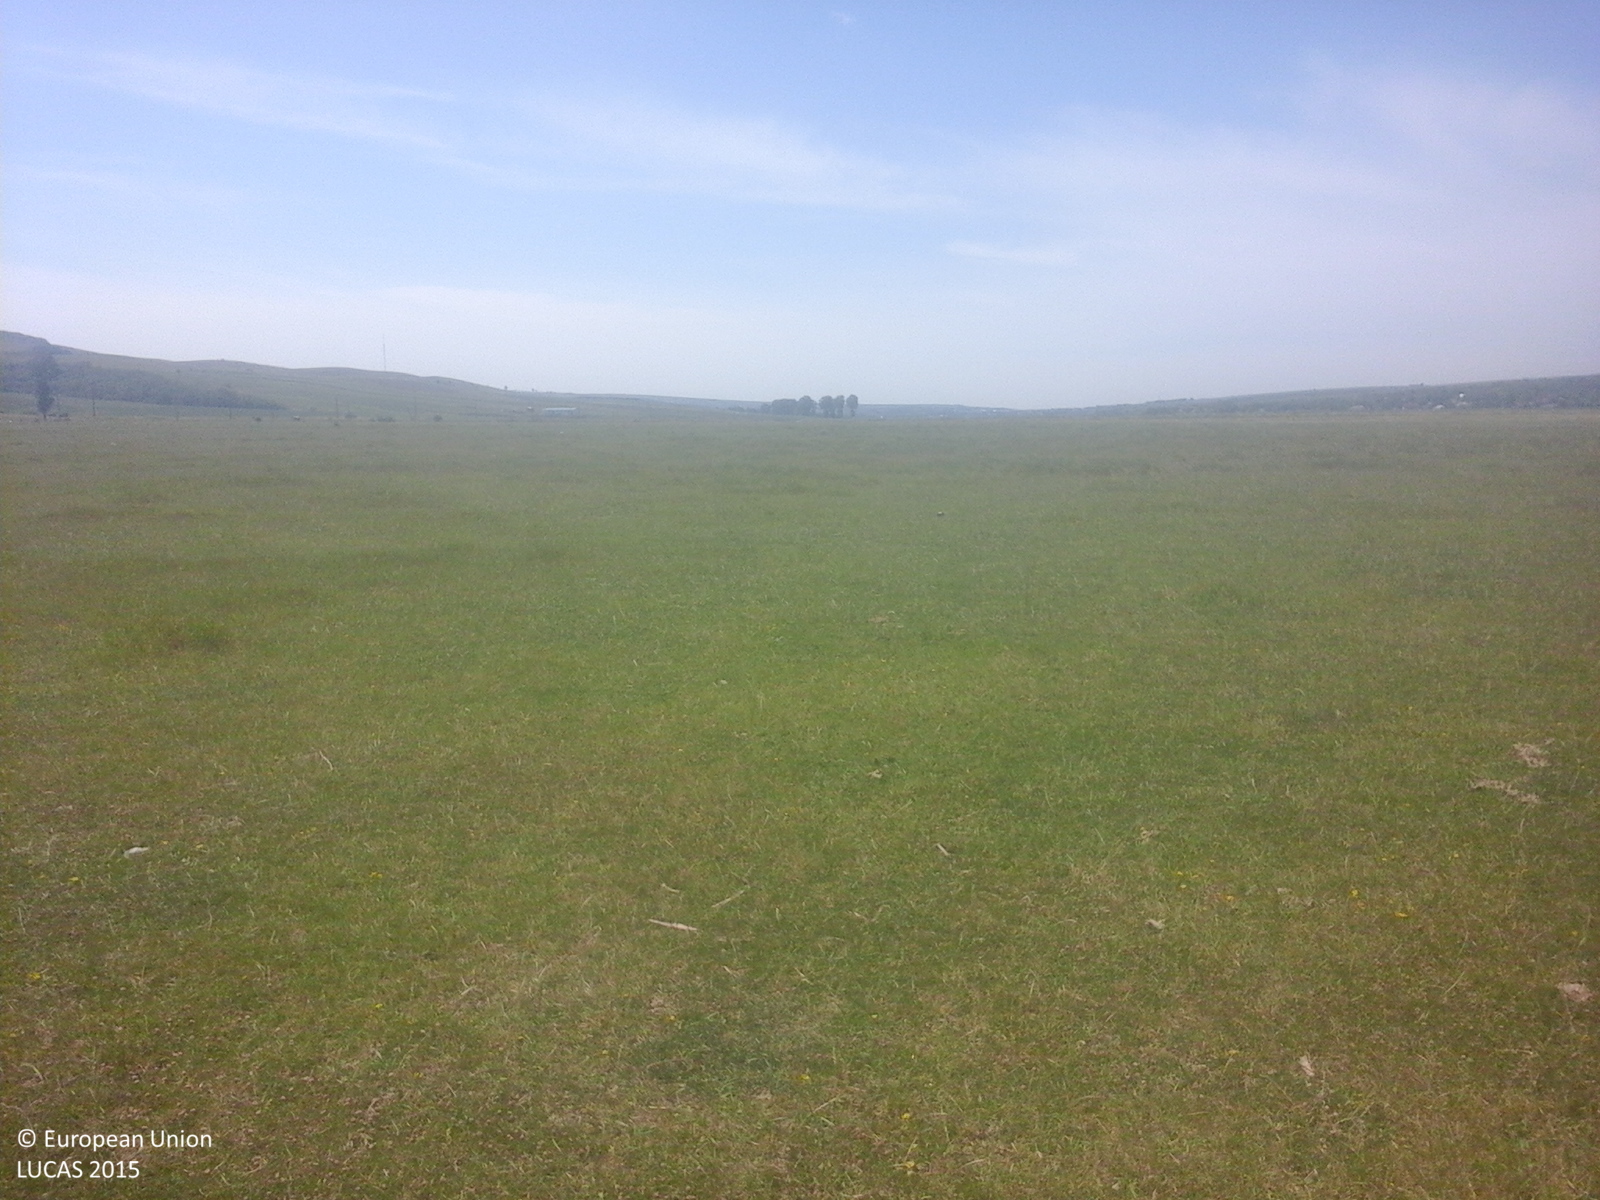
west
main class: Grassland
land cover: Grassland without tree/shrub cover
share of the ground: > 75 %
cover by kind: herbaceous plants 100 %
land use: Agriculture (excluding fallow land and kitchen gardens)
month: June
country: RO
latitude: 47.9310
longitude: 26.9286
